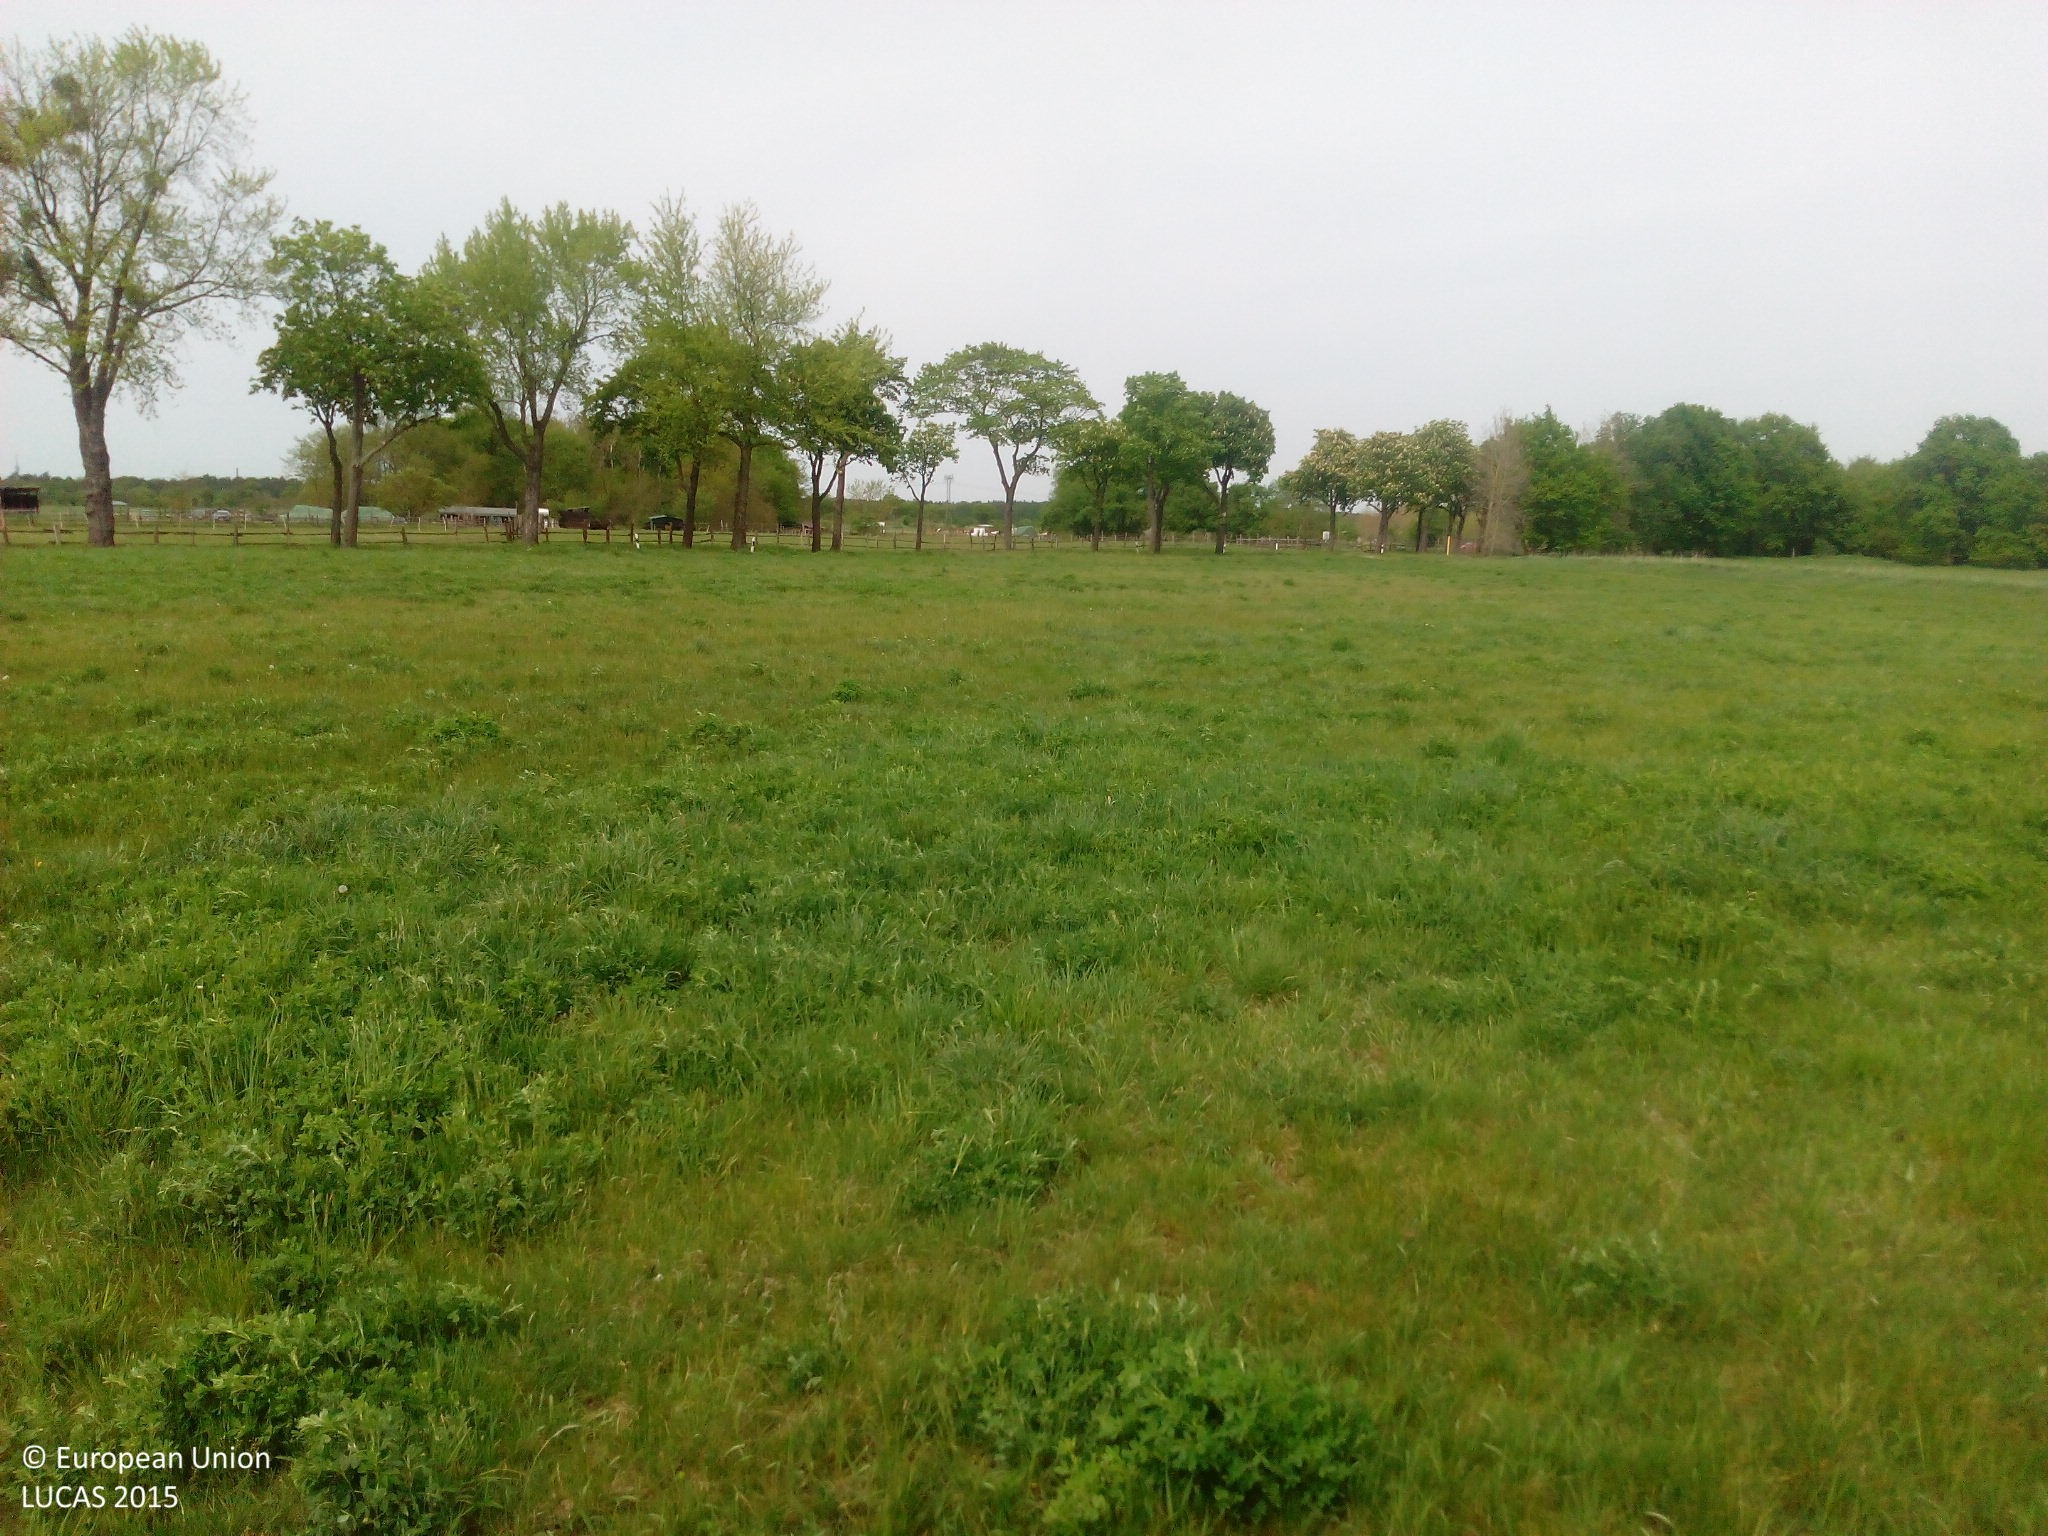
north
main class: Grassland
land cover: Grassland without tree/shrub cover
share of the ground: > 75 %
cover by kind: herbaceous plants 100 %
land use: Agriculture (excluding fallow land and kitchen gardens)
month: May
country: DE
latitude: 52.3348
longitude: 13.1846
